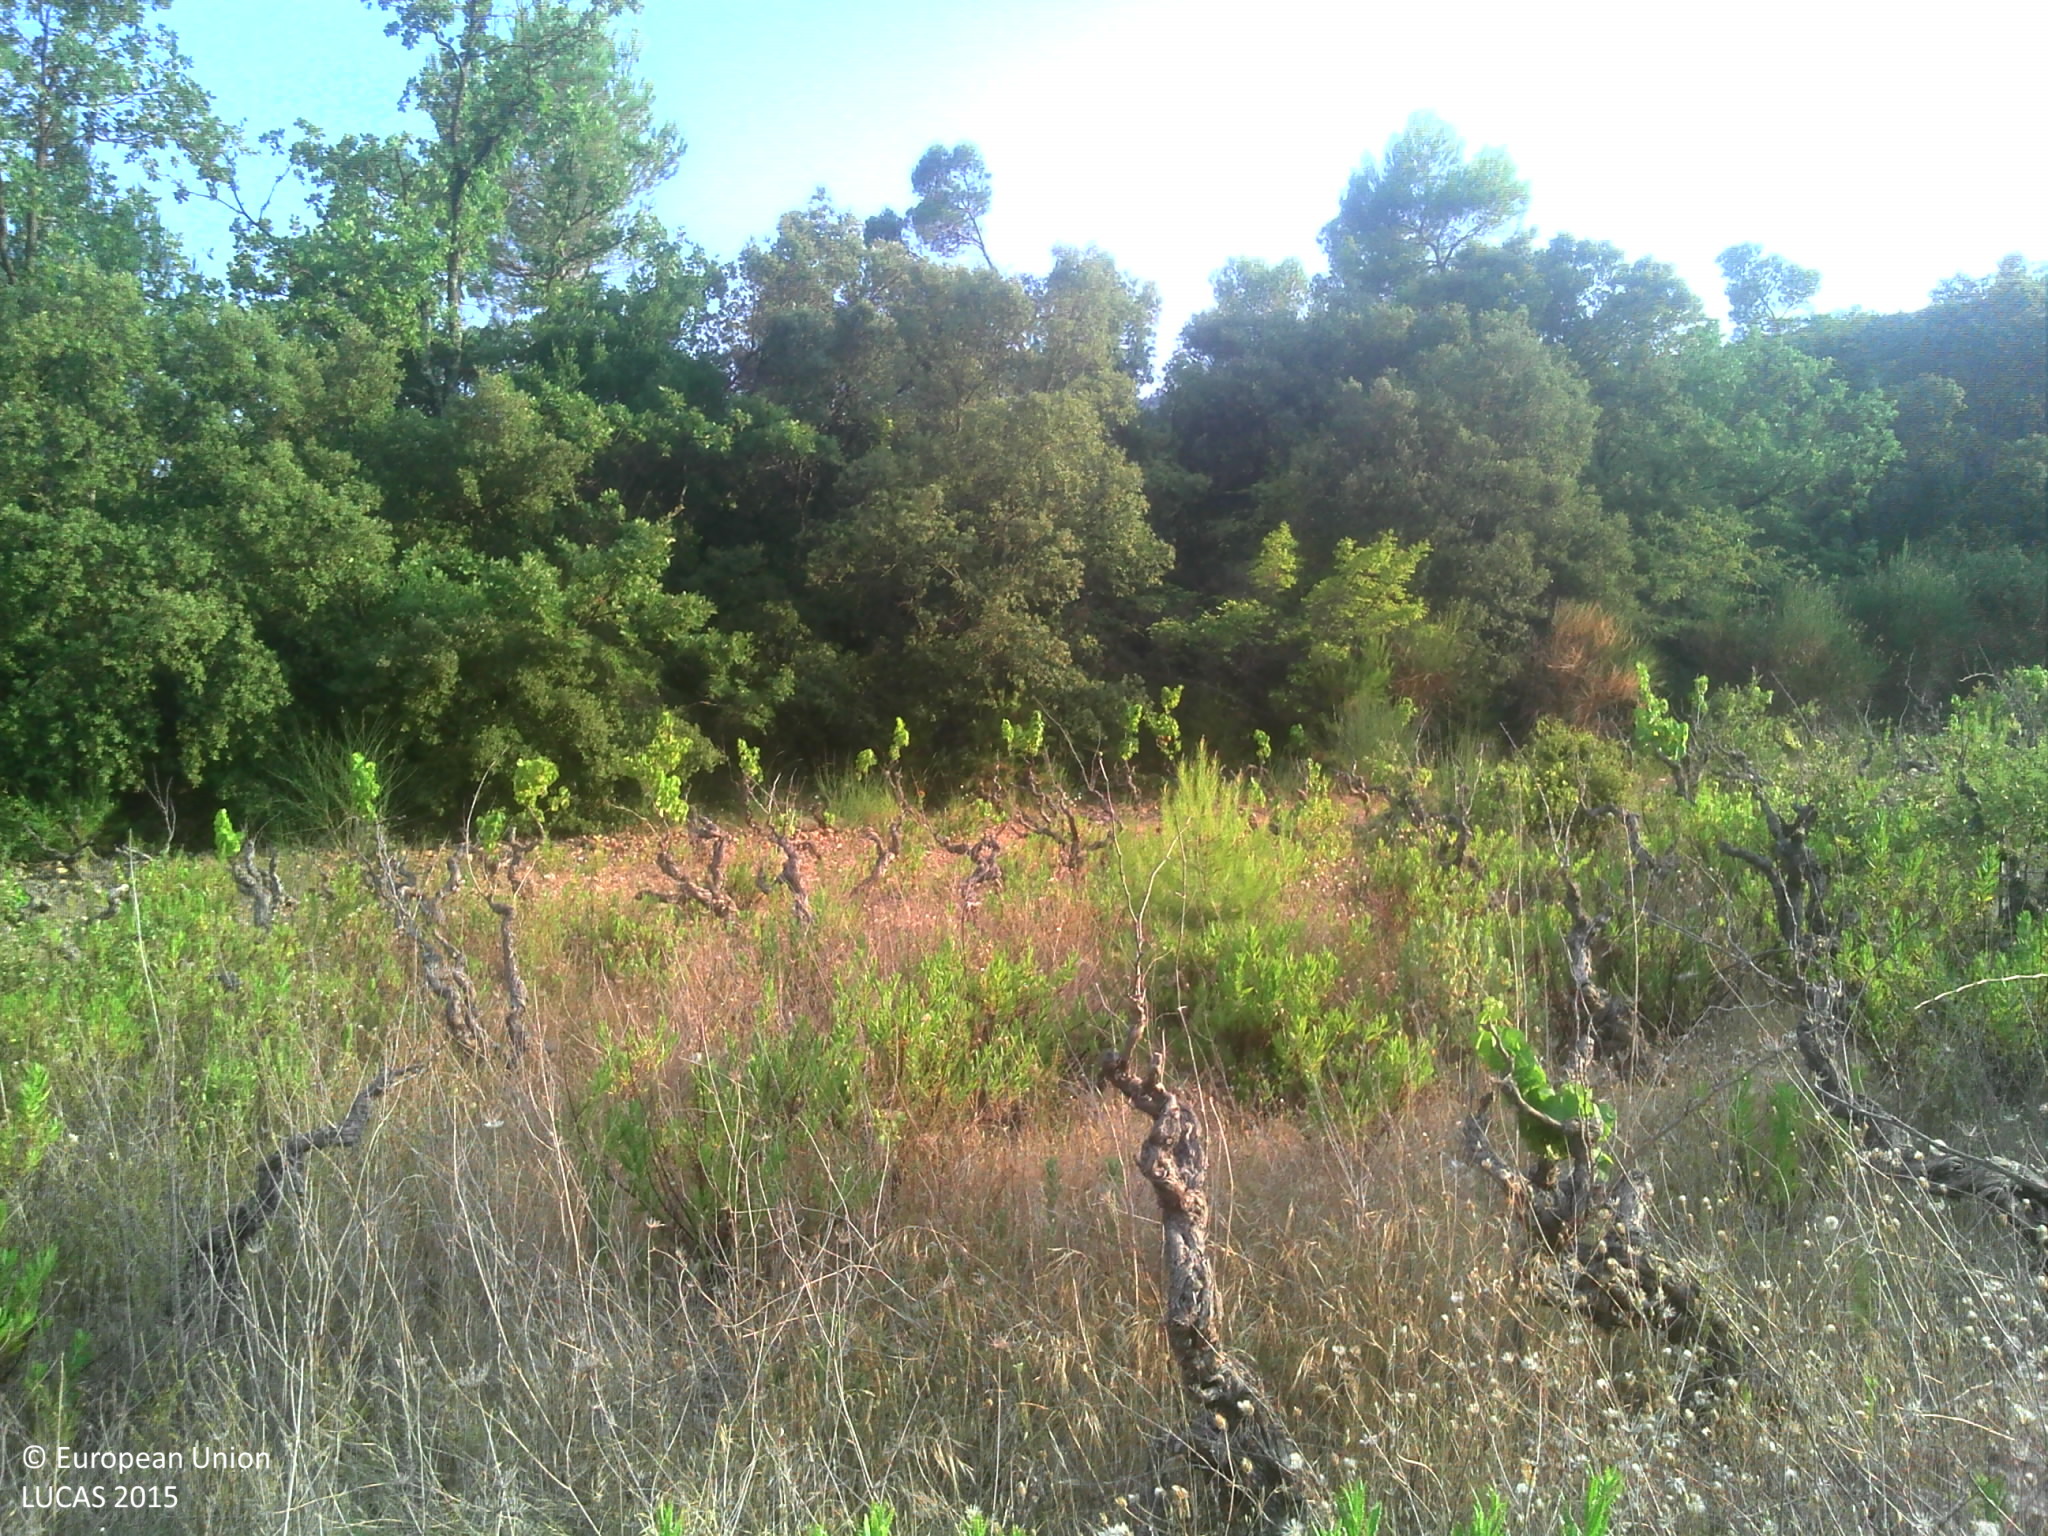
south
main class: Cropland
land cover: Vineyards
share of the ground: 25 - 50 %
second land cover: Grassland without tree/shrub cover
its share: > 75 %
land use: Abandoned areas
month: July
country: FR
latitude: 43.4192
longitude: 6.3407
